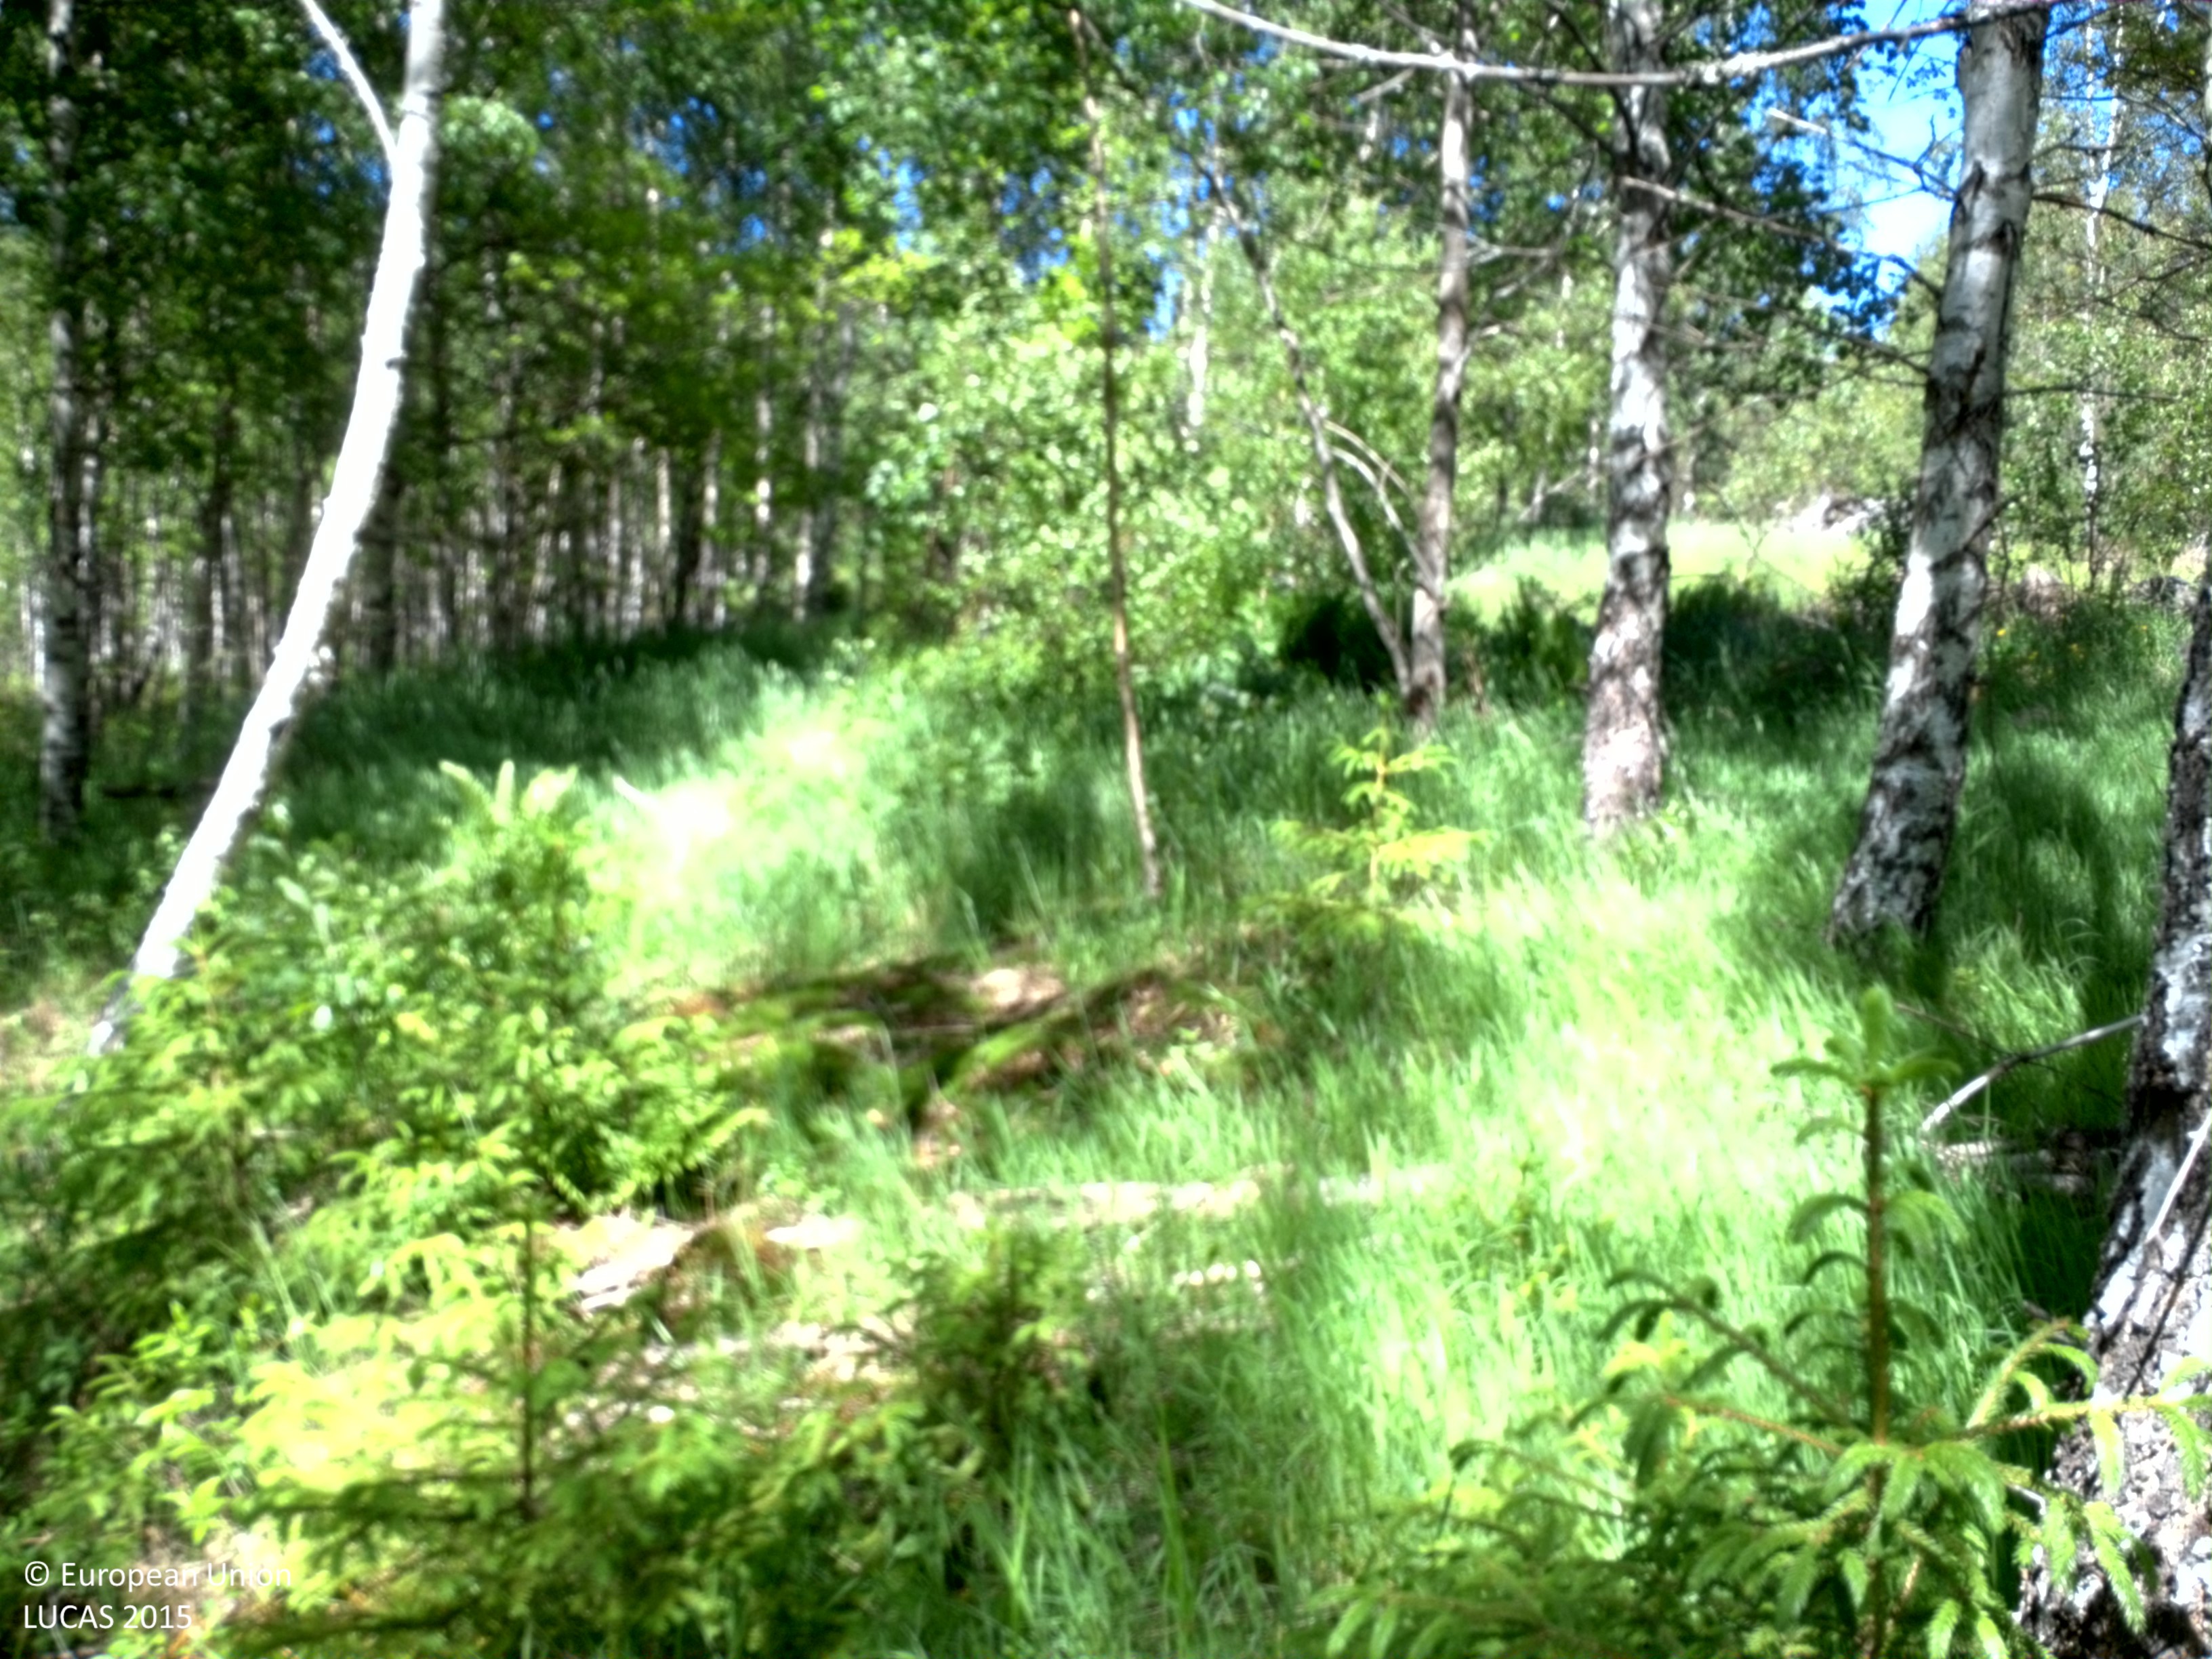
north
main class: Woodland
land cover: Broadleaved woodland
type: acidophilous oak and oak-birch forest
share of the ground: 25 - 50 %
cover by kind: herbaceous plants 50 %, broadleaved forest trees 35 %, lichens and mosses 10 %, coniferous forest trees 5 %
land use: Forestry
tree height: > 5 m
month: June
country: SE
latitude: 58.6875
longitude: 16.2571
